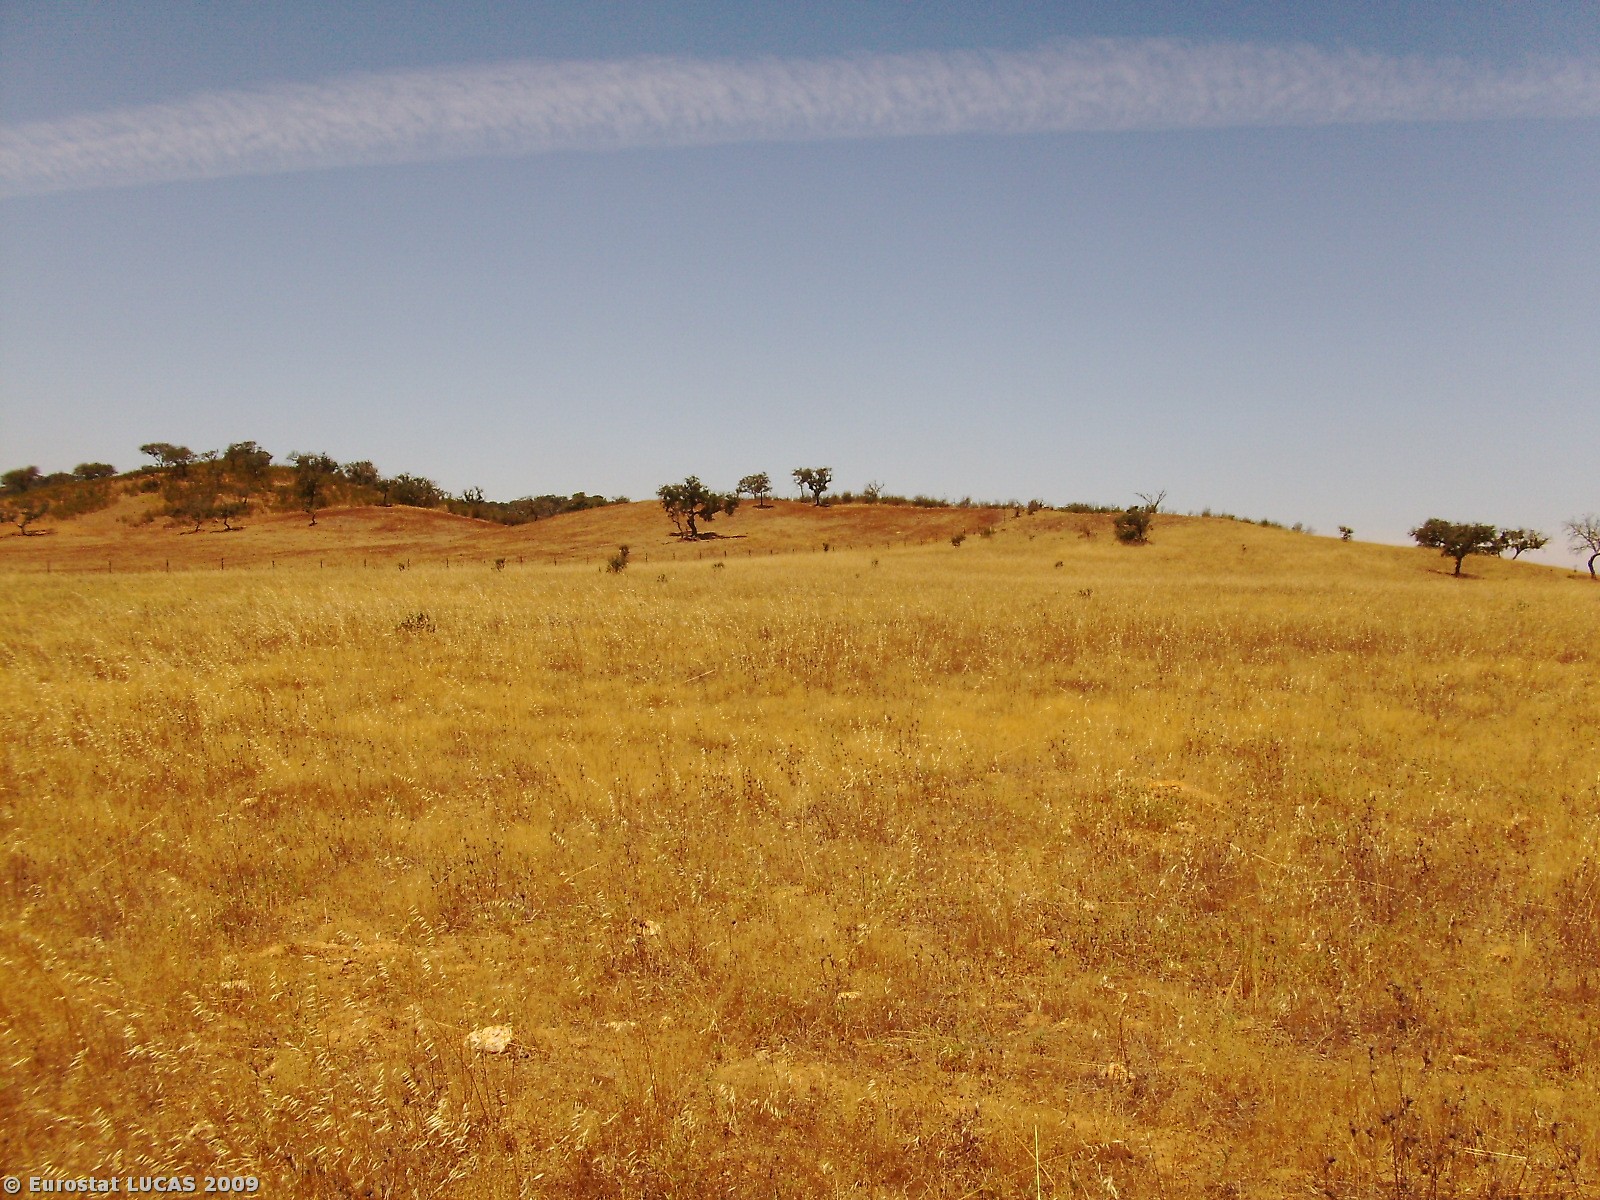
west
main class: Grassland
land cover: Grassland with sparse tree/shrub cover
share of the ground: > 75 %
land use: Agriculture (excluding fallow land and kitchen gardens)
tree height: > 5 m
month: July
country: PT
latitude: 37.7535
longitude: -8.3880
